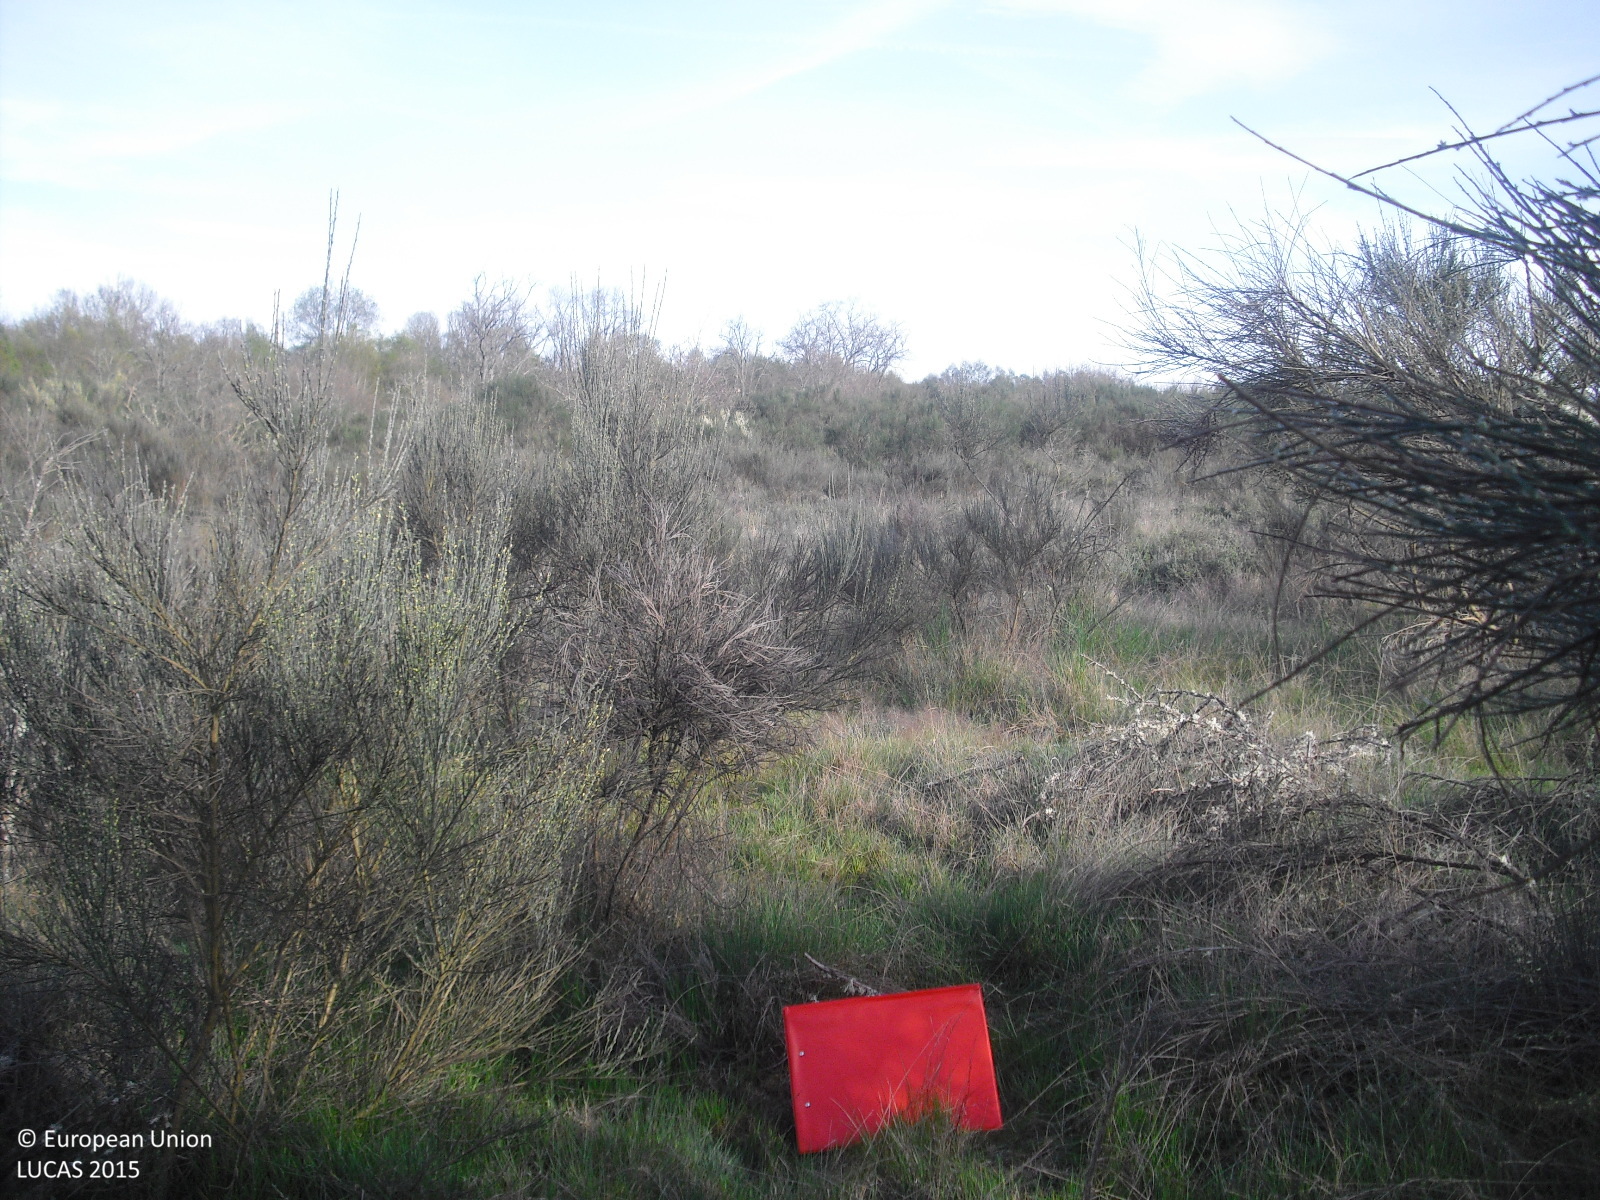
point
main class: Shrubland
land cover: Shrubland without tree cover
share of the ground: > 75 %
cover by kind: shrubs 70 %, herbaceous plants 30 %
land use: Abandoned areas
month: April
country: ES
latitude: 41.9224
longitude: -7.6337
